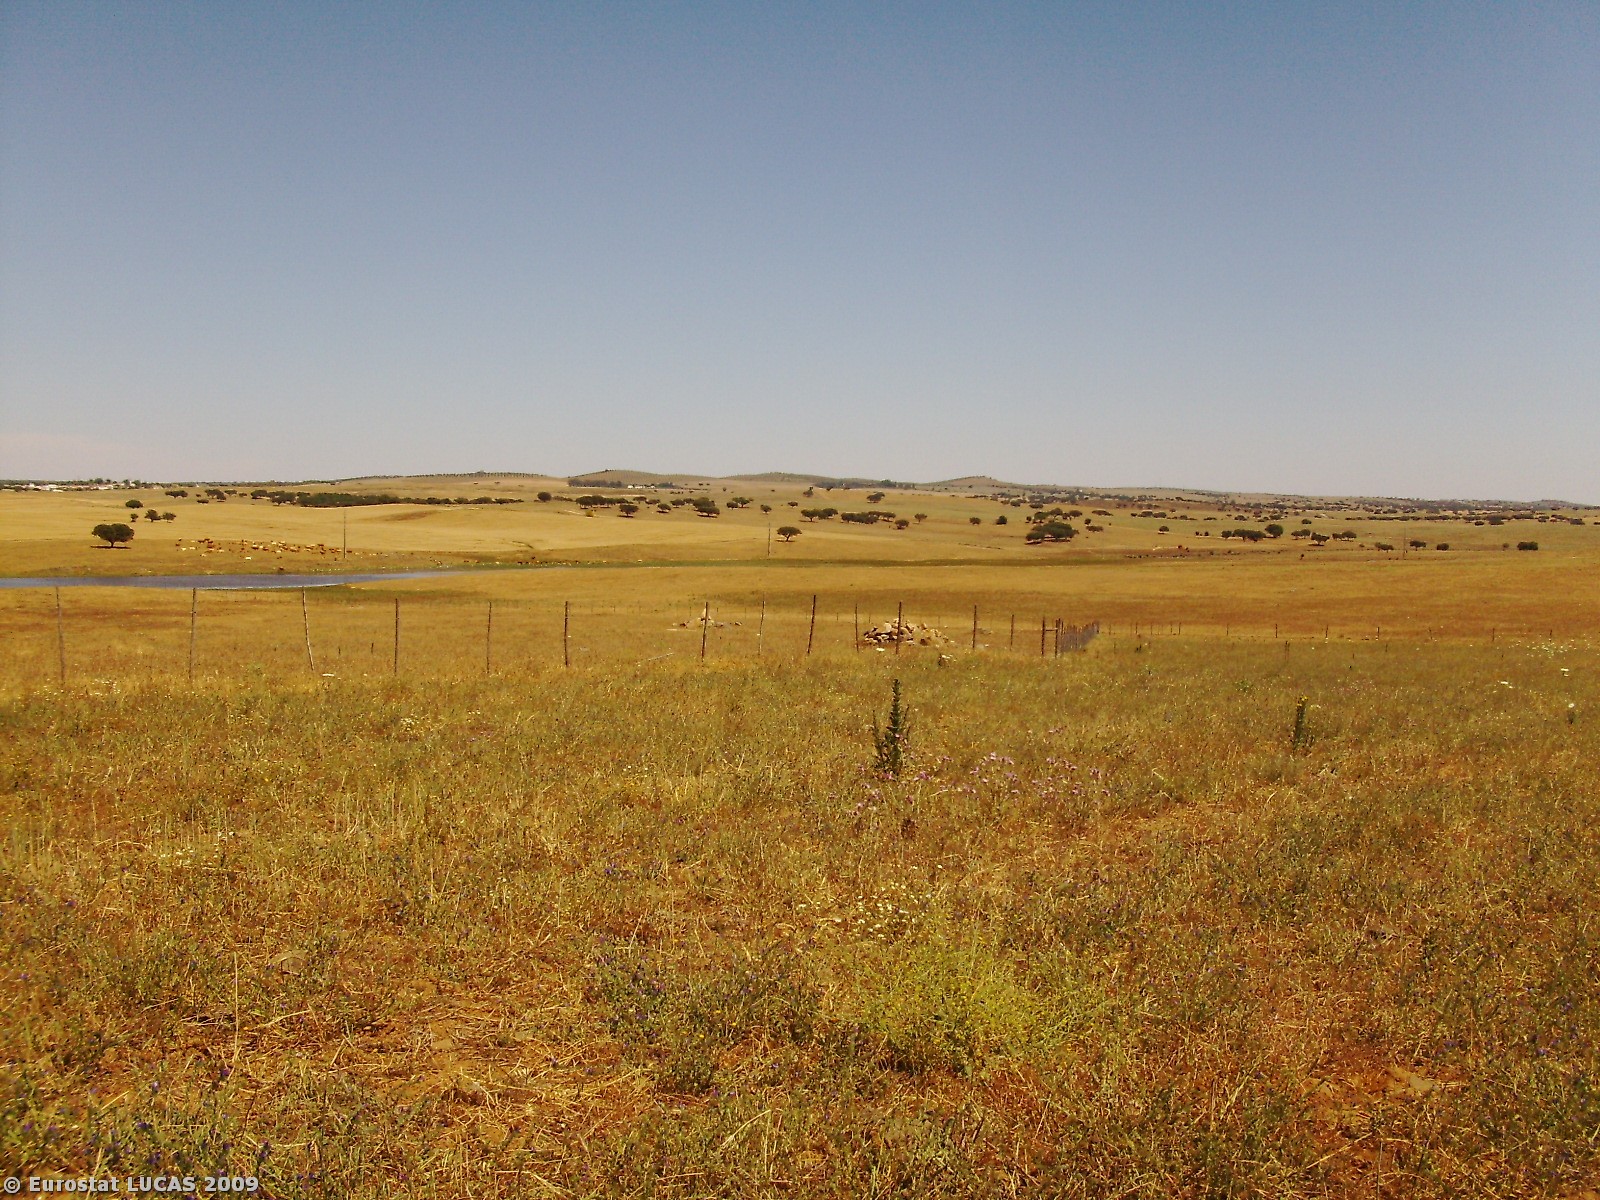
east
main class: Grassland
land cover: Spontaneously vegetated surfaces
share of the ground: > 75 %
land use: Fallow land
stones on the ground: 10 - 25 %
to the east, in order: Spontaneously vegetated surfaces; Fences; Grassland without tree/shrub cover; Fences; Grassland without tree/shrub cover
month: May
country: PT
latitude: 38.9084
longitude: -7.3653
